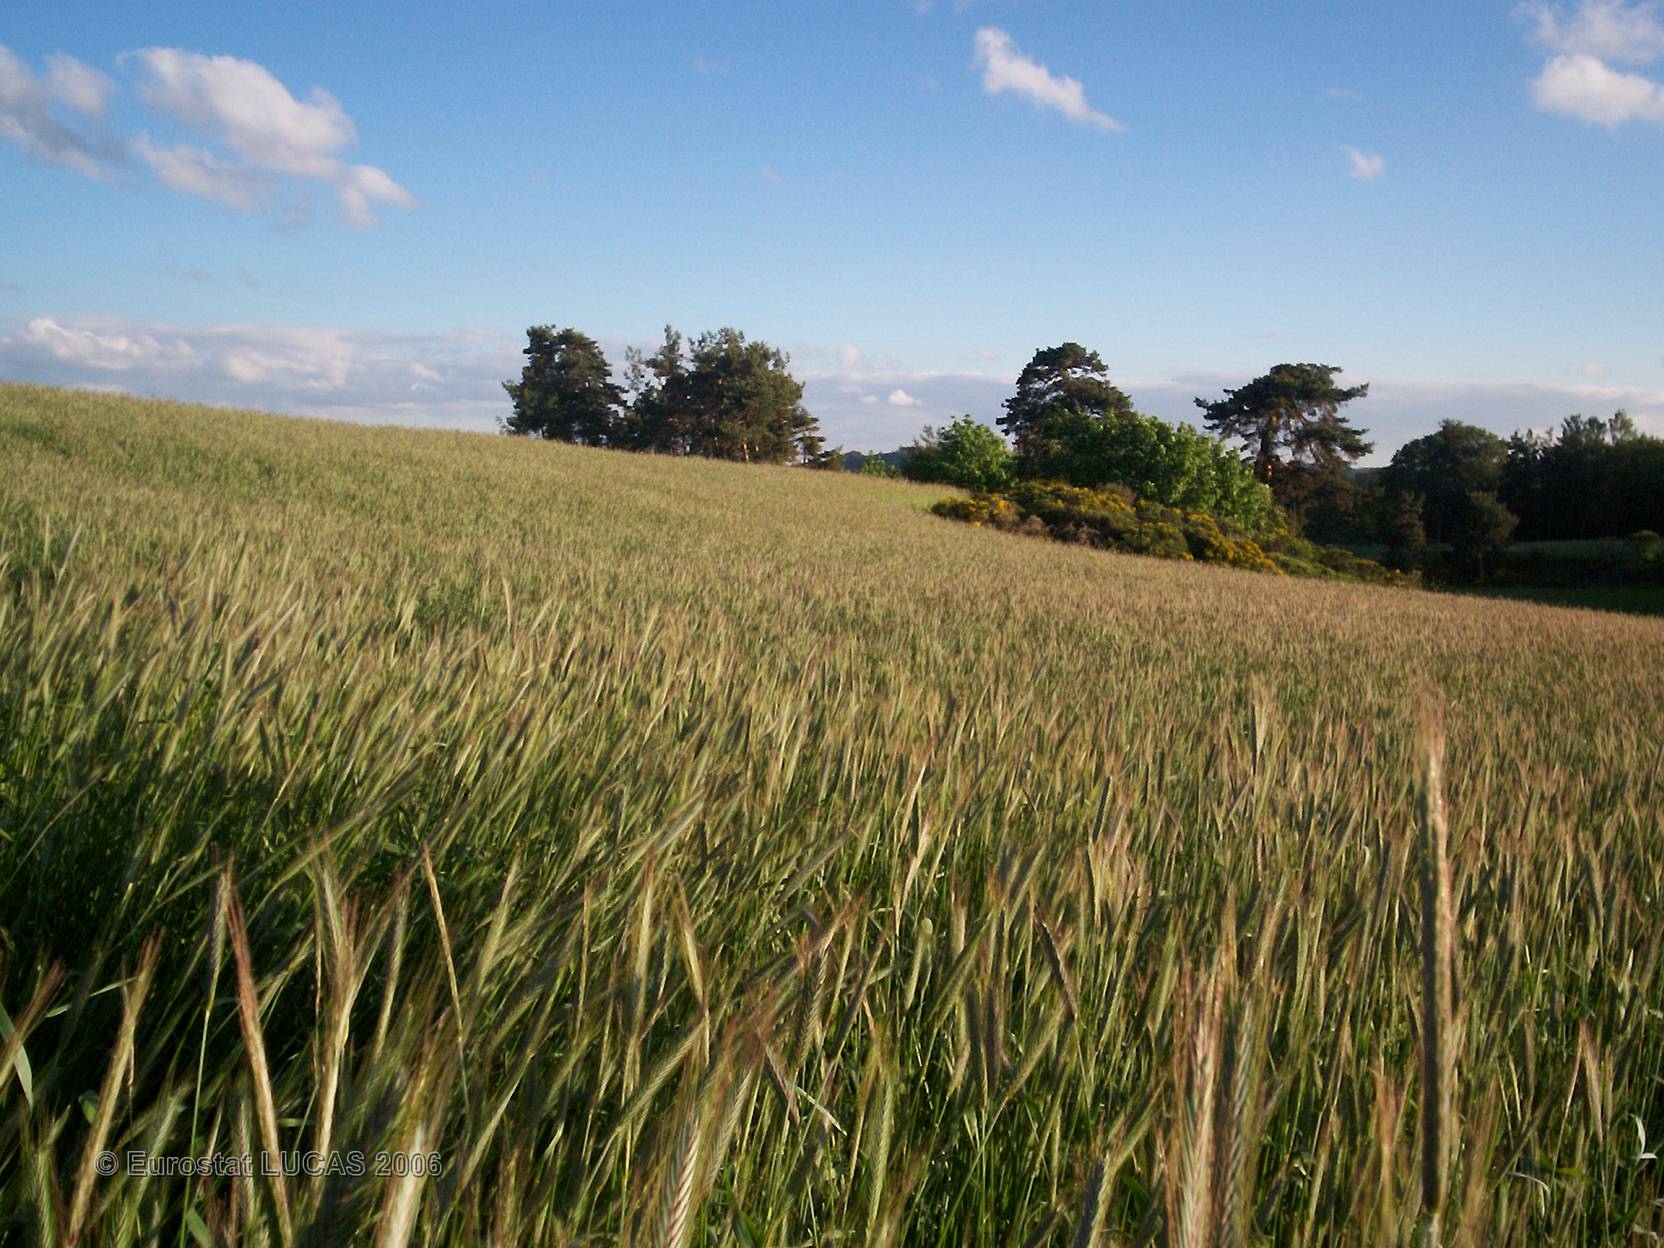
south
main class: Cropland
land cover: Common wheat
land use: Agriculture (excluding fallow land and kitchen gardens)
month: May
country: FR
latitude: 44.6623
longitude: 3.3578
